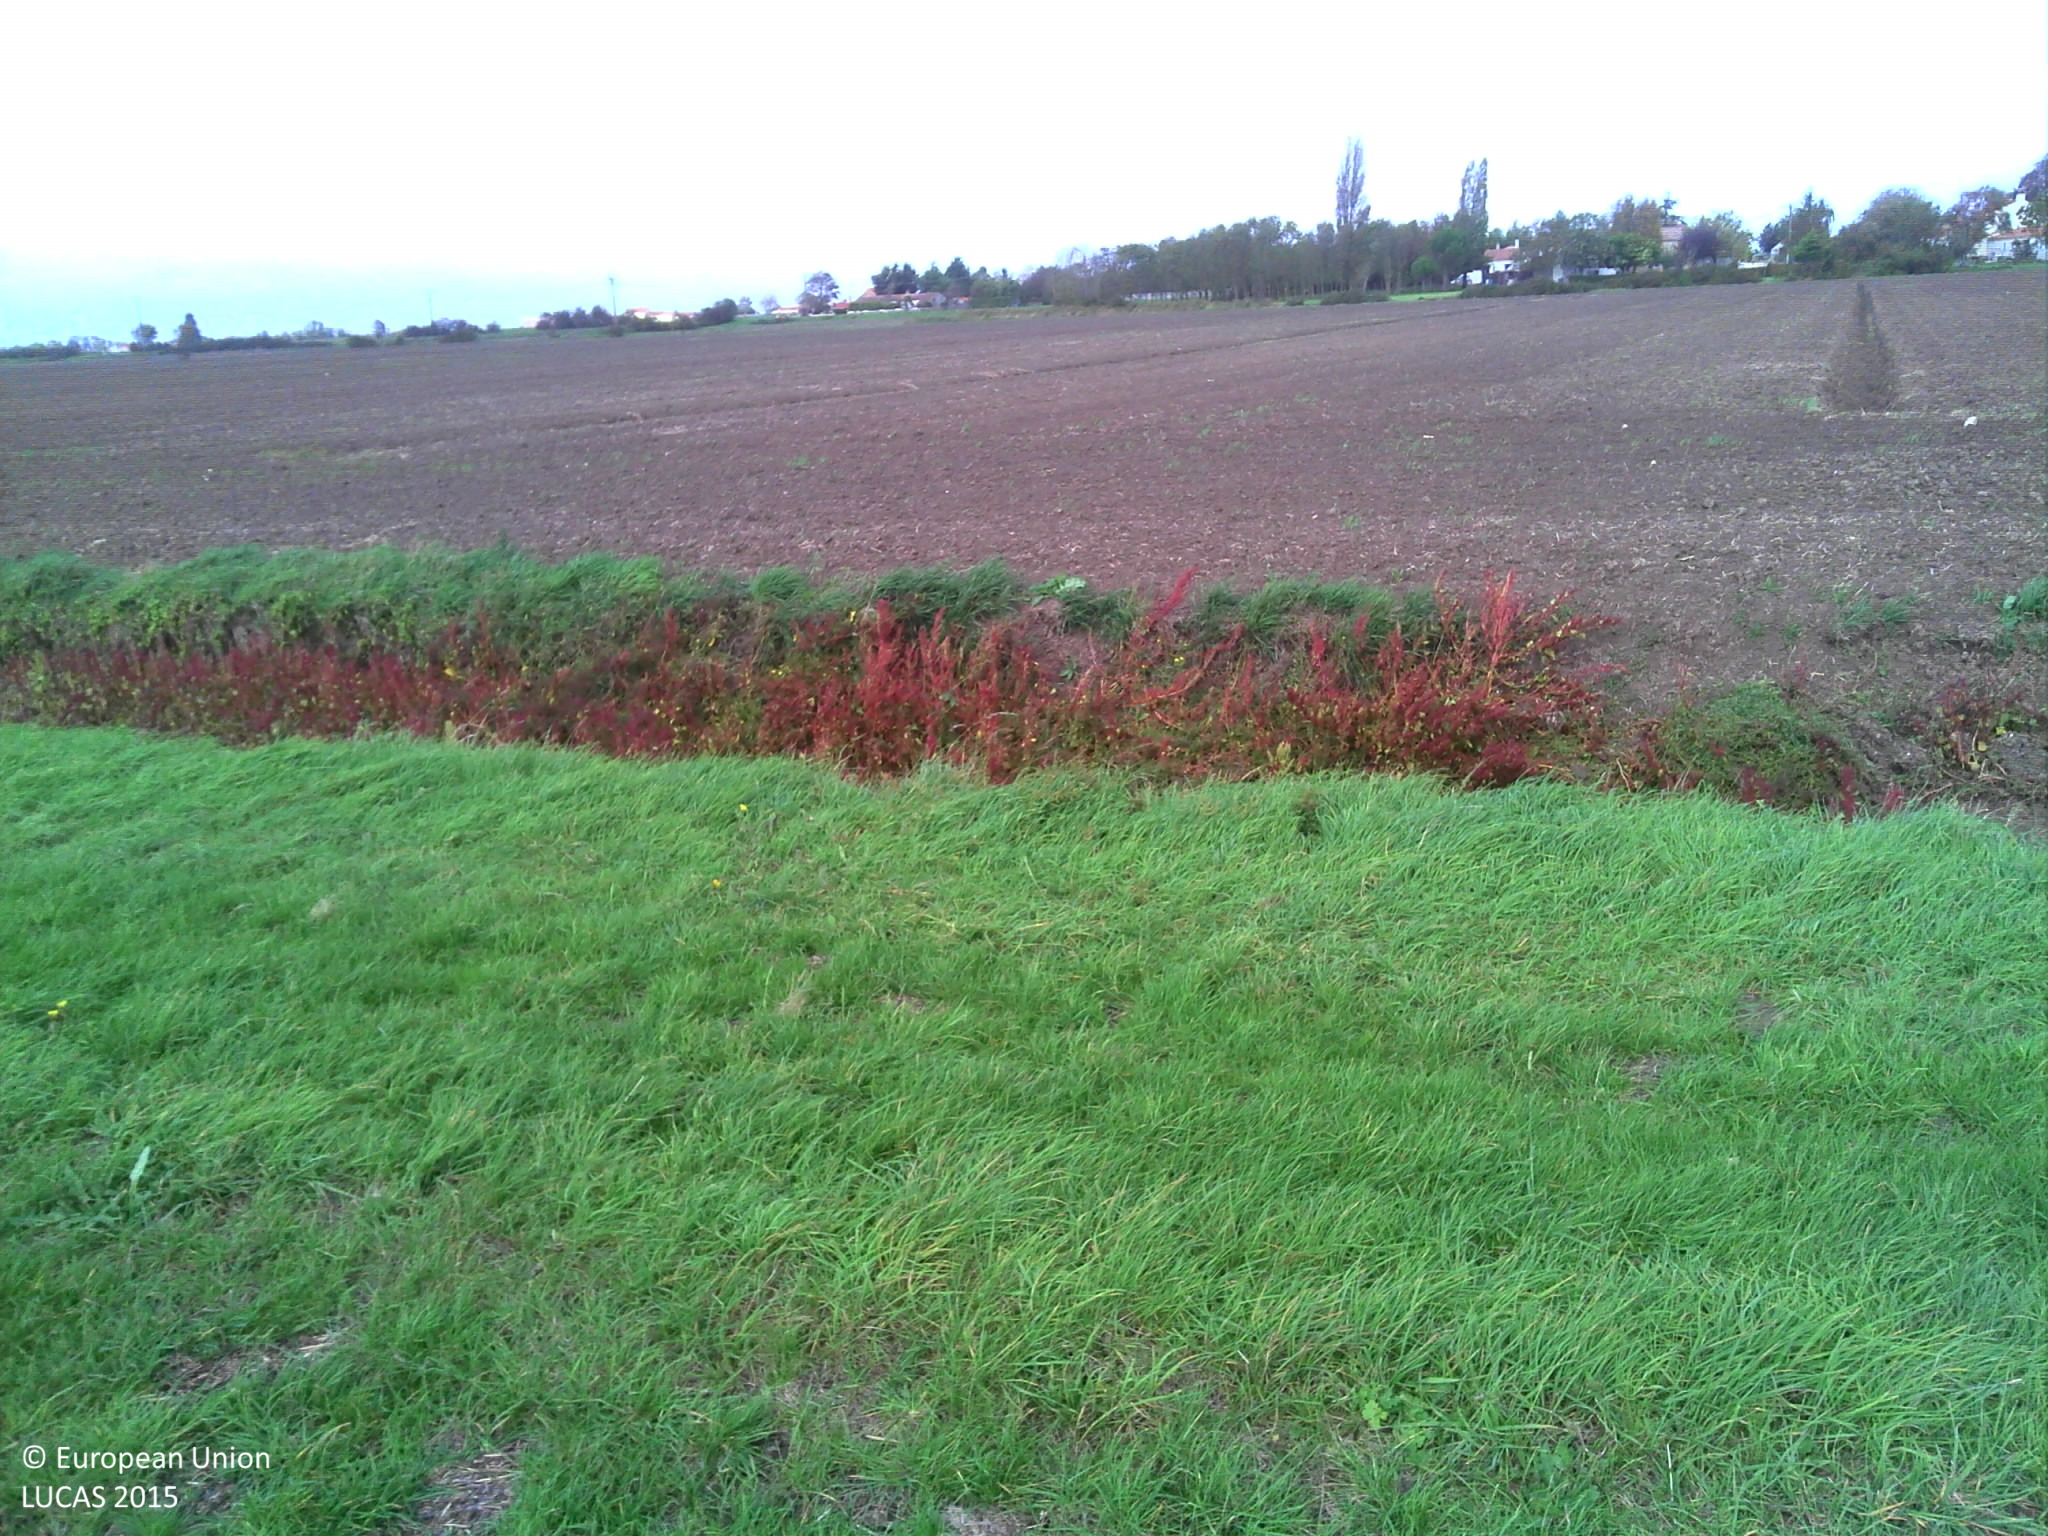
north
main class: Grassland
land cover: Grassland without tree/shrub cover
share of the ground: < 10 %
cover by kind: herbaceous plants 100 %
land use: Agriculture (excluding fallow land and kitchen gardens)
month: October
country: FR
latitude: 46.3718
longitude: -1.0951
